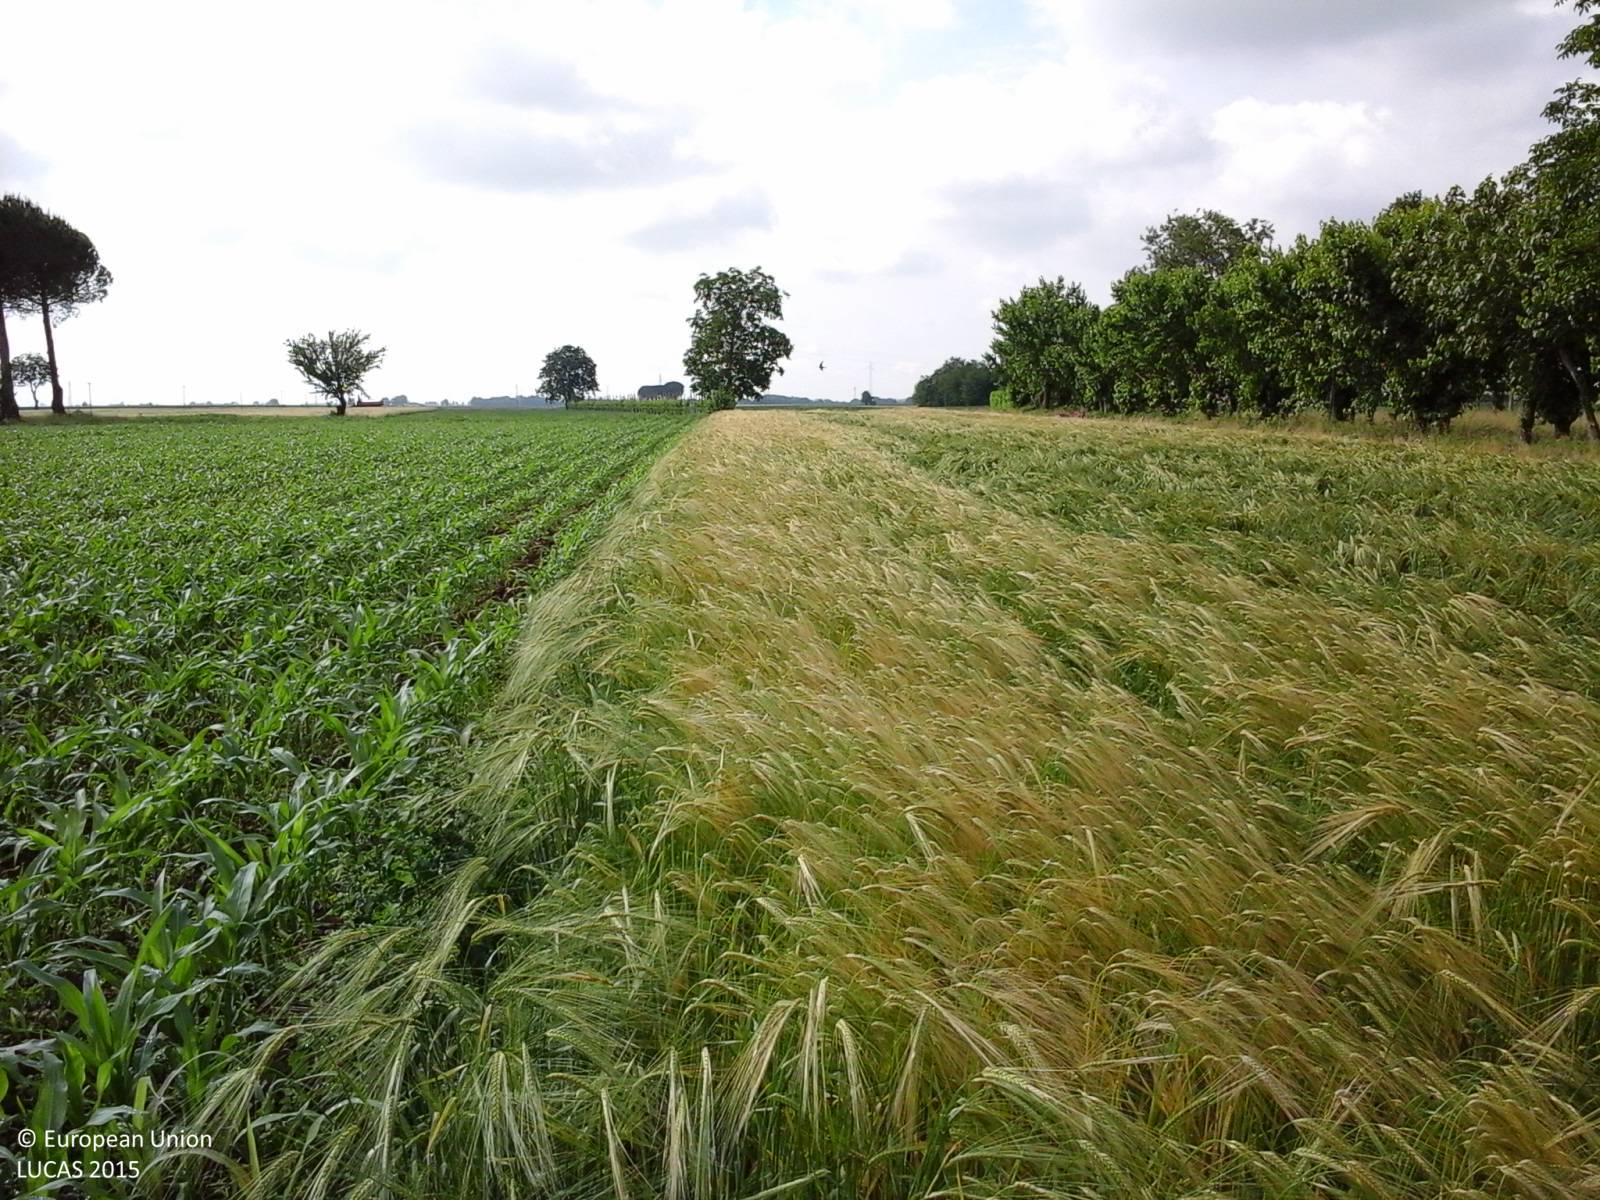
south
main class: Cropland
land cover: Barley
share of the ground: > 75 %
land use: Agriculture (excluding fallow land and kitchen gardens)
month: May
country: IT
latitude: 46.0198
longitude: 13.0320
